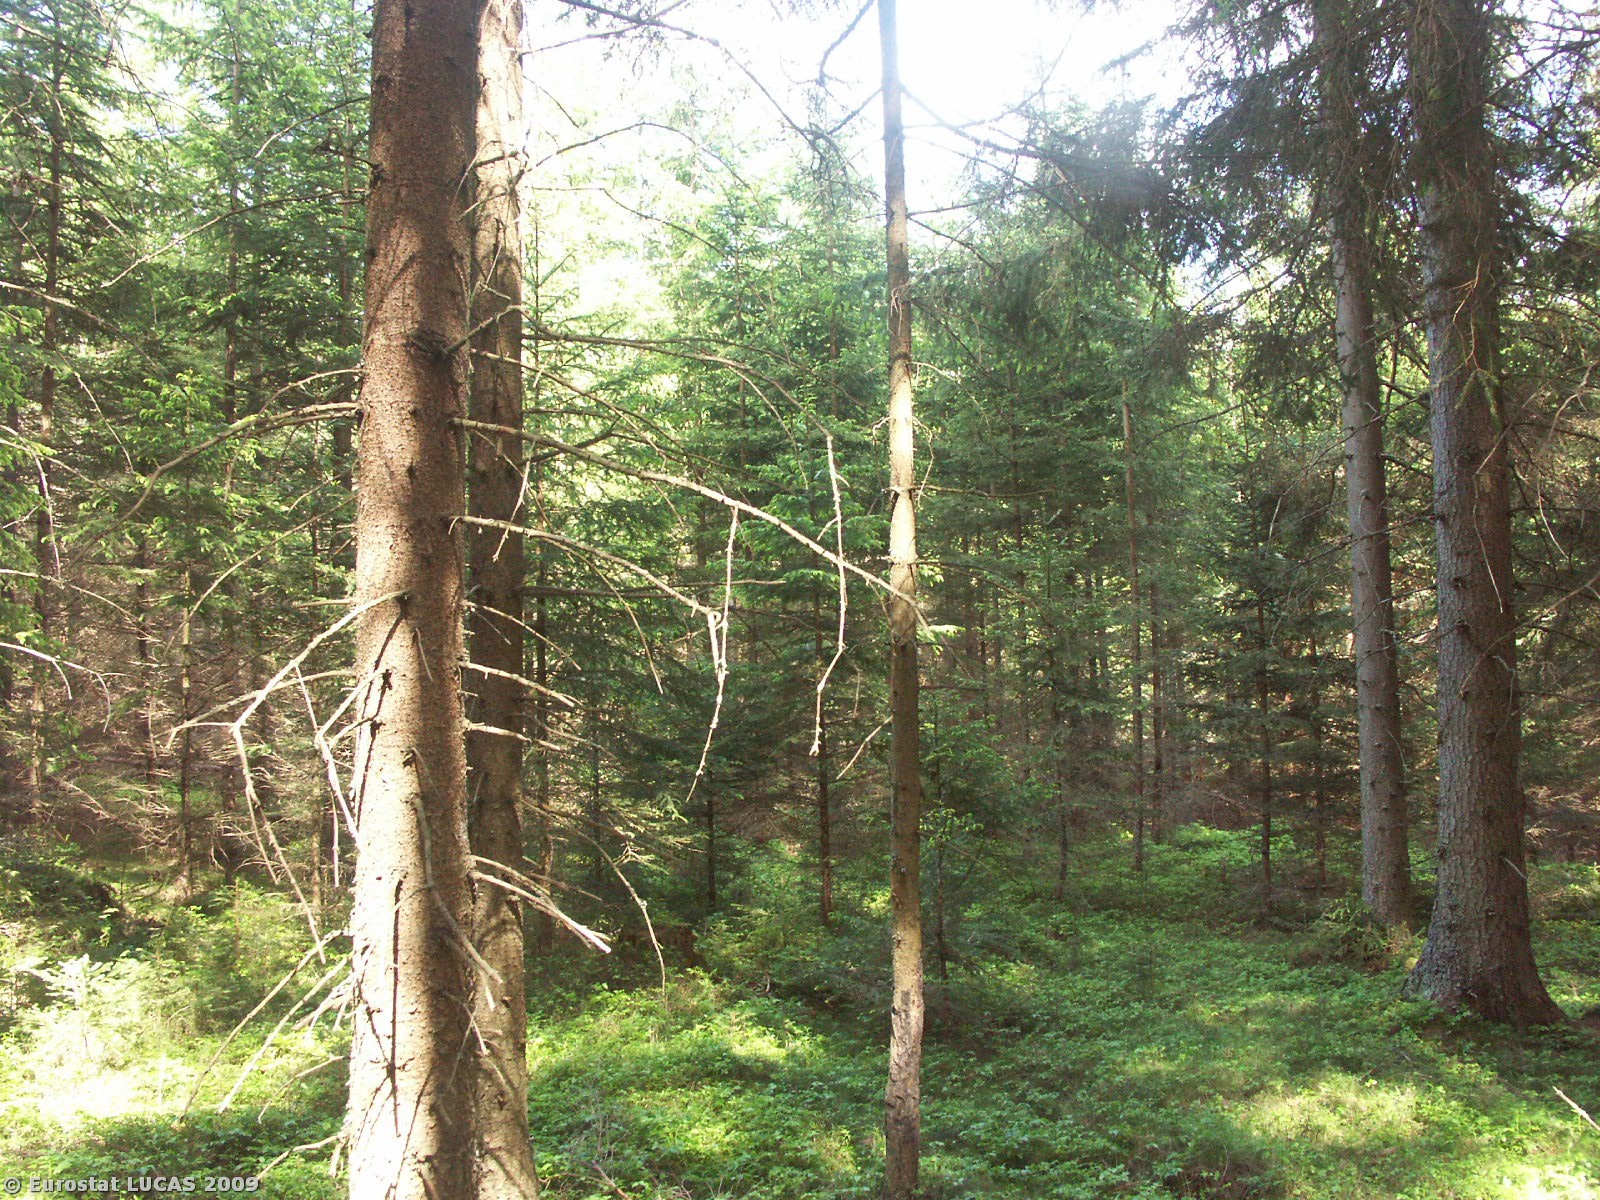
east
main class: Woodland
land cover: Coniferous woodland
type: hemiboreal forest and nemoral coniferous forest and mixed broadleaved-coniferous forest
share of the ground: > 75 %
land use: Forestry
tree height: > 5 m
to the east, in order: Coniferous woodland; Tracks; Coniferous woodland; Mixed woodland; Tracks; Broadleaved woodland; Spontaneously vegetated surfaces; Ditches and canals; Paved roads, cycling and walking lanes; Ditches and canals; Mixed woodland
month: May
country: CZ
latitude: 48.6490
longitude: 14.6296
